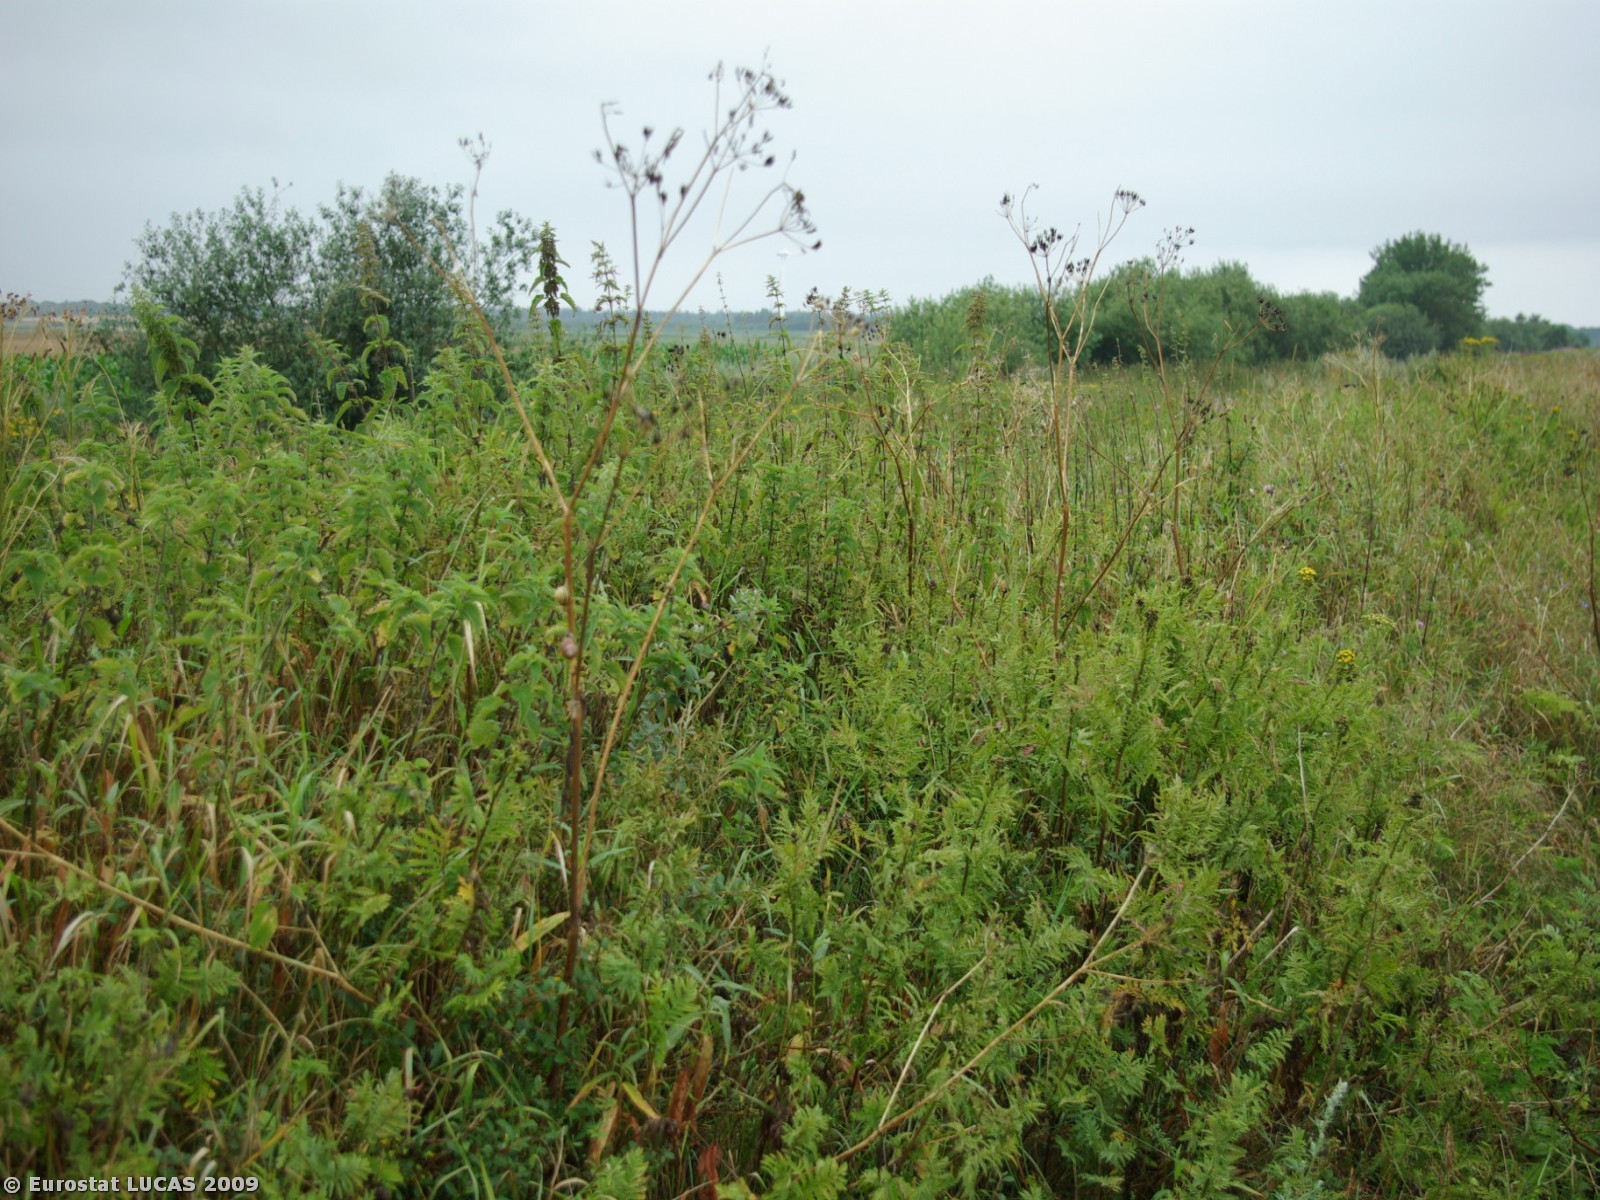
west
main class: Cropland
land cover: Rye
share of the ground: > 75 %
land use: Agriculture (excluding fallow land and kitchen gardens)
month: July
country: DK
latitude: 55.0669
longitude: 8.7326
